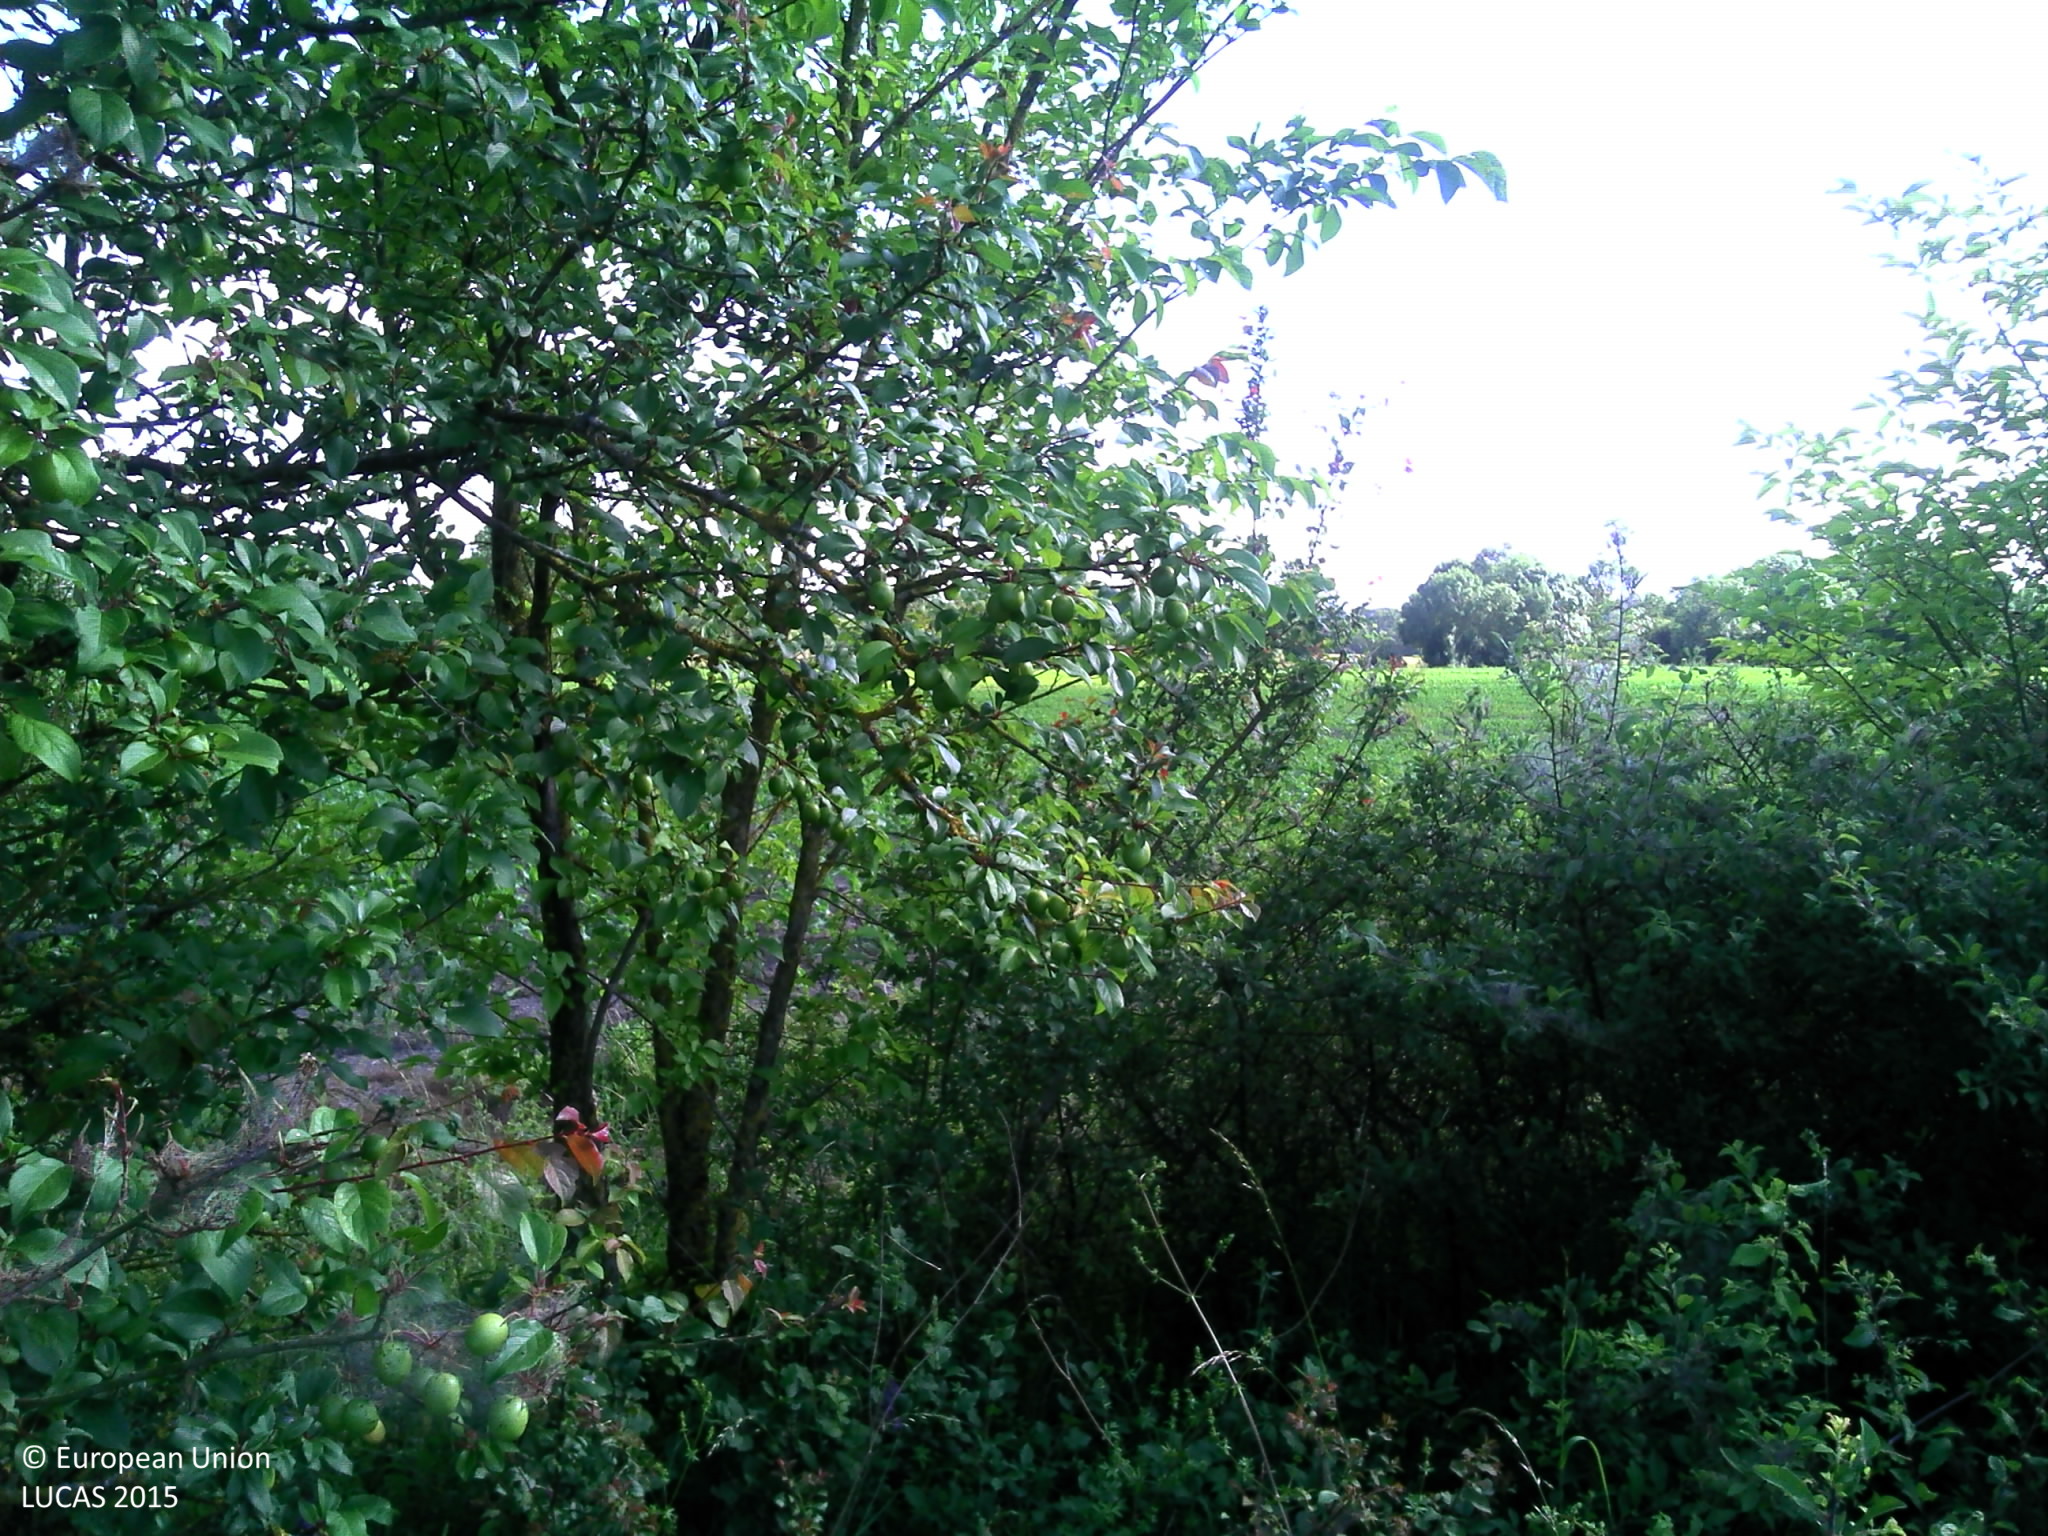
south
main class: Grassland
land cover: Grassland without tree/shrub cover
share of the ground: > 75 %
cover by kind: herbaceous plants 100 %
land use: Agriculture (excluding fallow land and kitchen gardens)
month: June
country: FR
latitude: 46.2731
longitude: -0.9958
